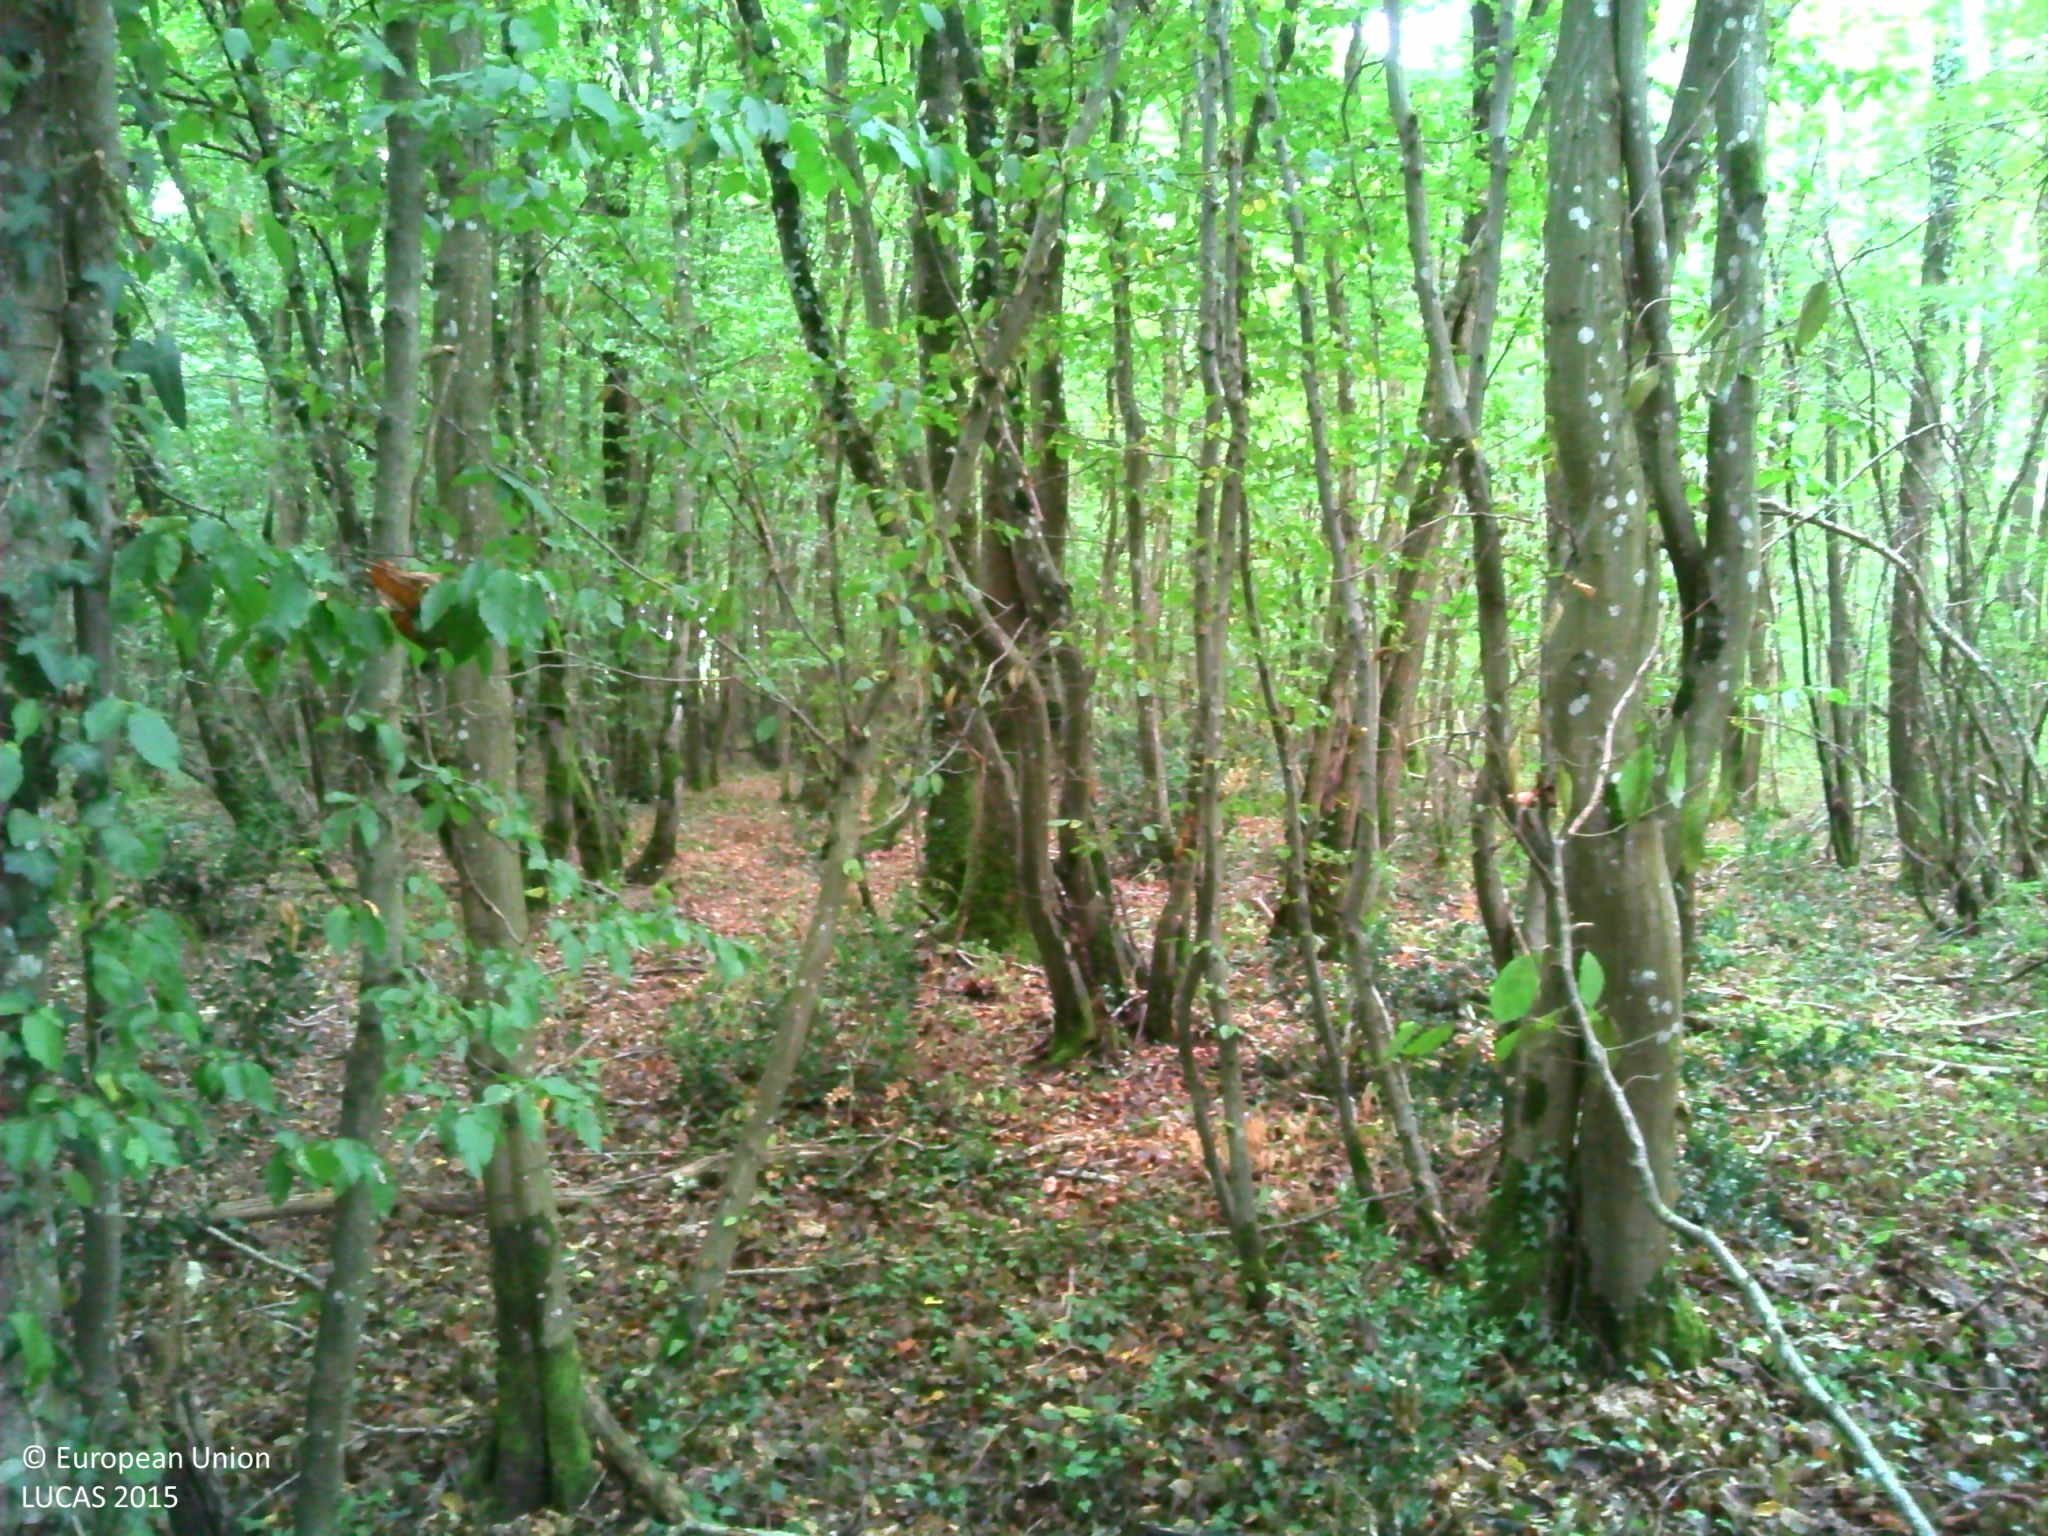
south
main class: Woodland
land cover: Broadleaved woodland
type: acidophilous oak and oak-birch forest
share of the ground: > 75 %
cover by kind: broadleaved forest trees 60 %, unconsolidated bare surface 30 %, herbaceous plants 10 %
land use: Forestry
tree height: > 5 m
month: August
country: FR
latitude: 48.1327
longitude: 2.8029
